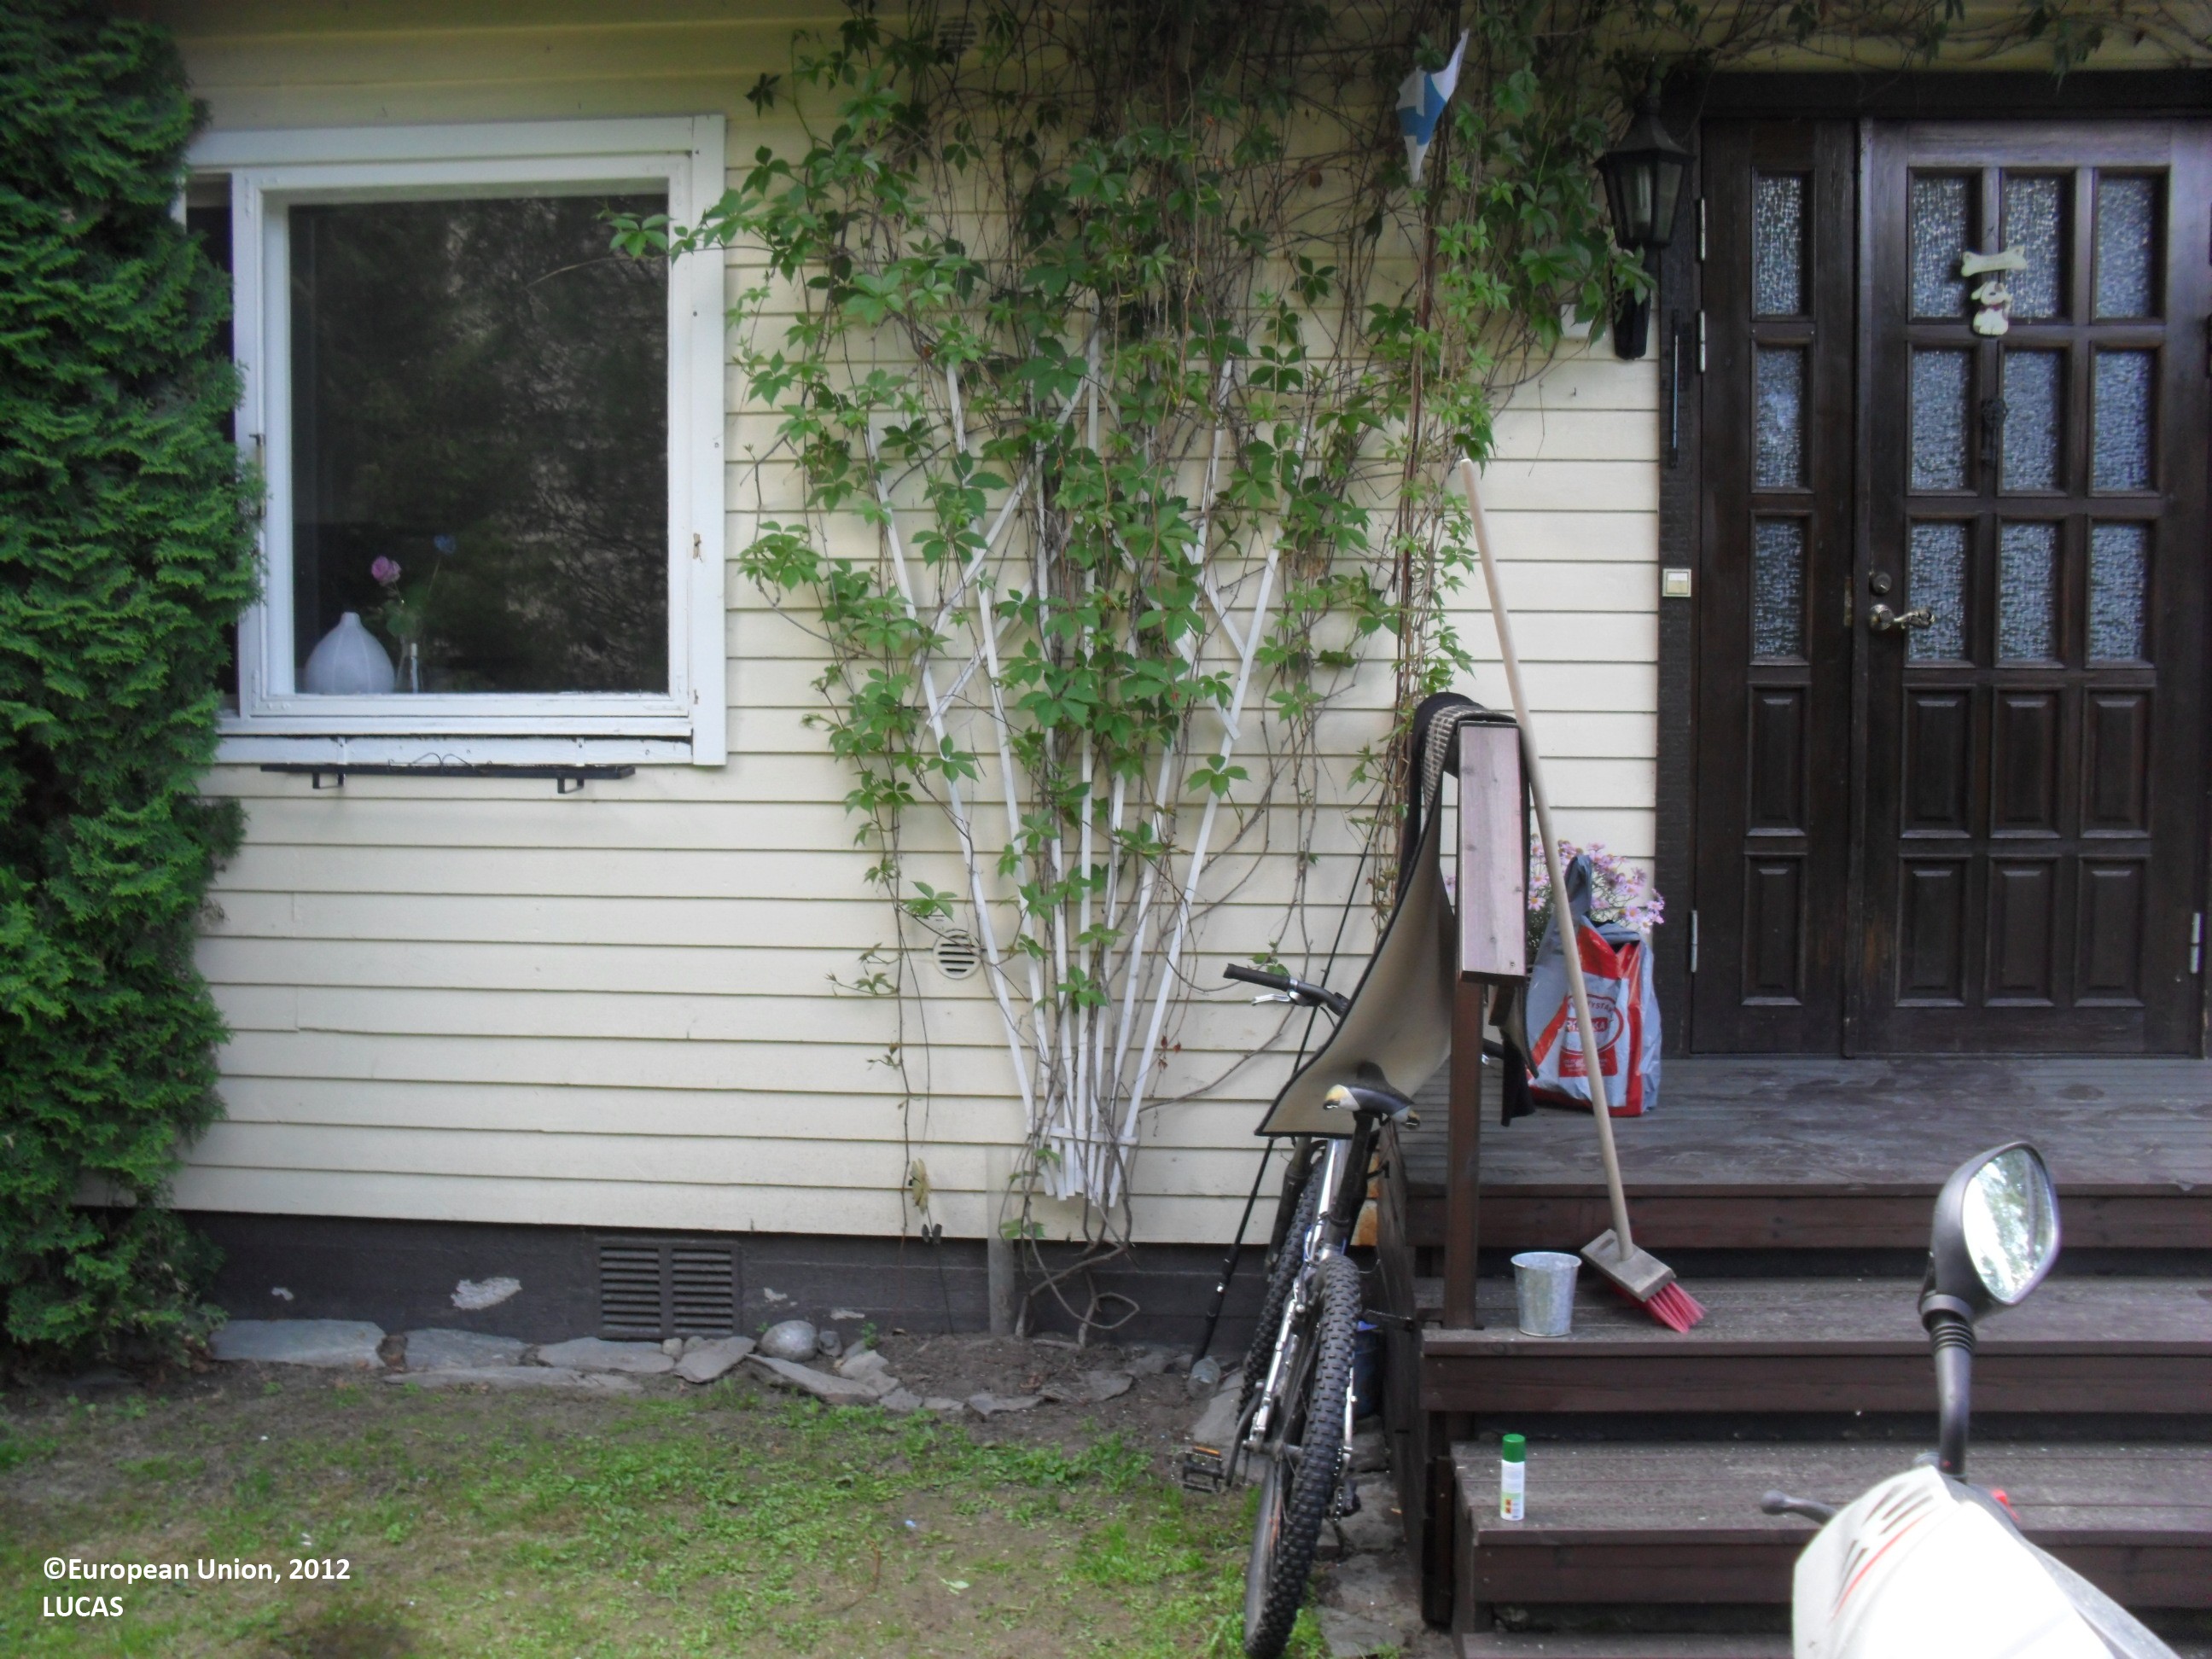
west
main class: Grassland
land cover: Grassland without tree/shrub cover
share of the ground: > 75 %
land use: Residential
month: June
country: FI
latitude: 62.8076
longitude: 23.5045
